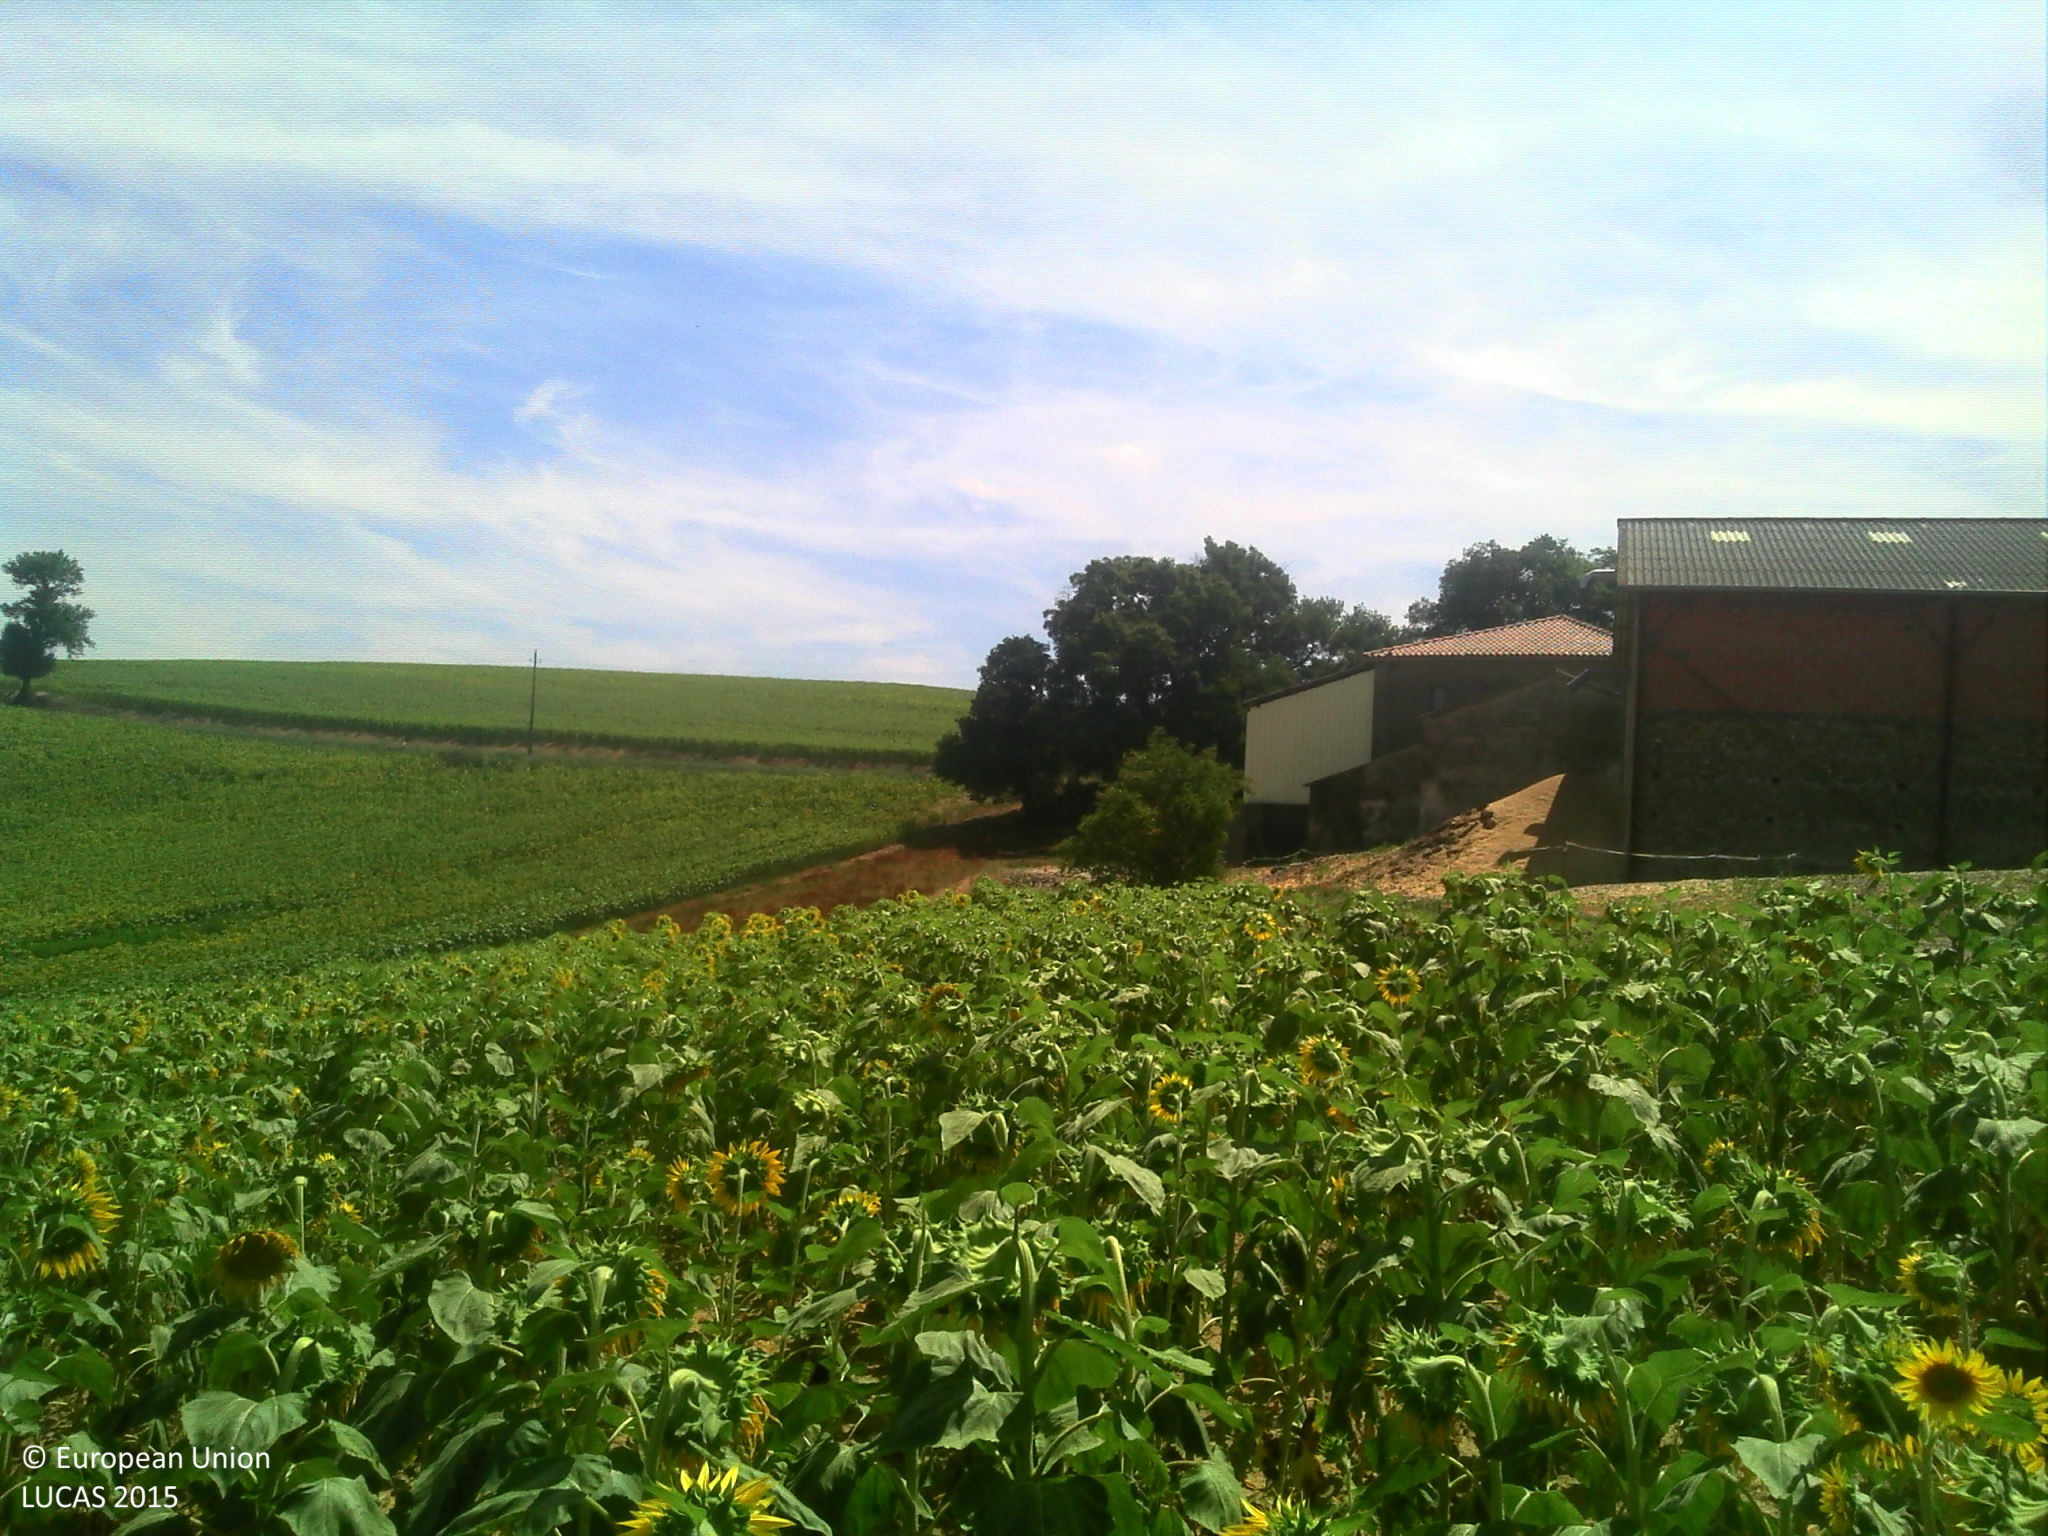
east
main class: Cropland
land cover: Sunflower
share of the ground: > 75 %
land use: Agriculture (excluding fallow land and kitchen gardens)
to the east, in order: Sunflower; Fences; Grassland without tree/shrub cover; Fences; Sunflower; Grass margins; Paved roads, cycling and walking lanes; Grass margins; Ditches and canals; Sunflower
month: July
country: FR
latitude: 43.3565
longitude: 1.3792
